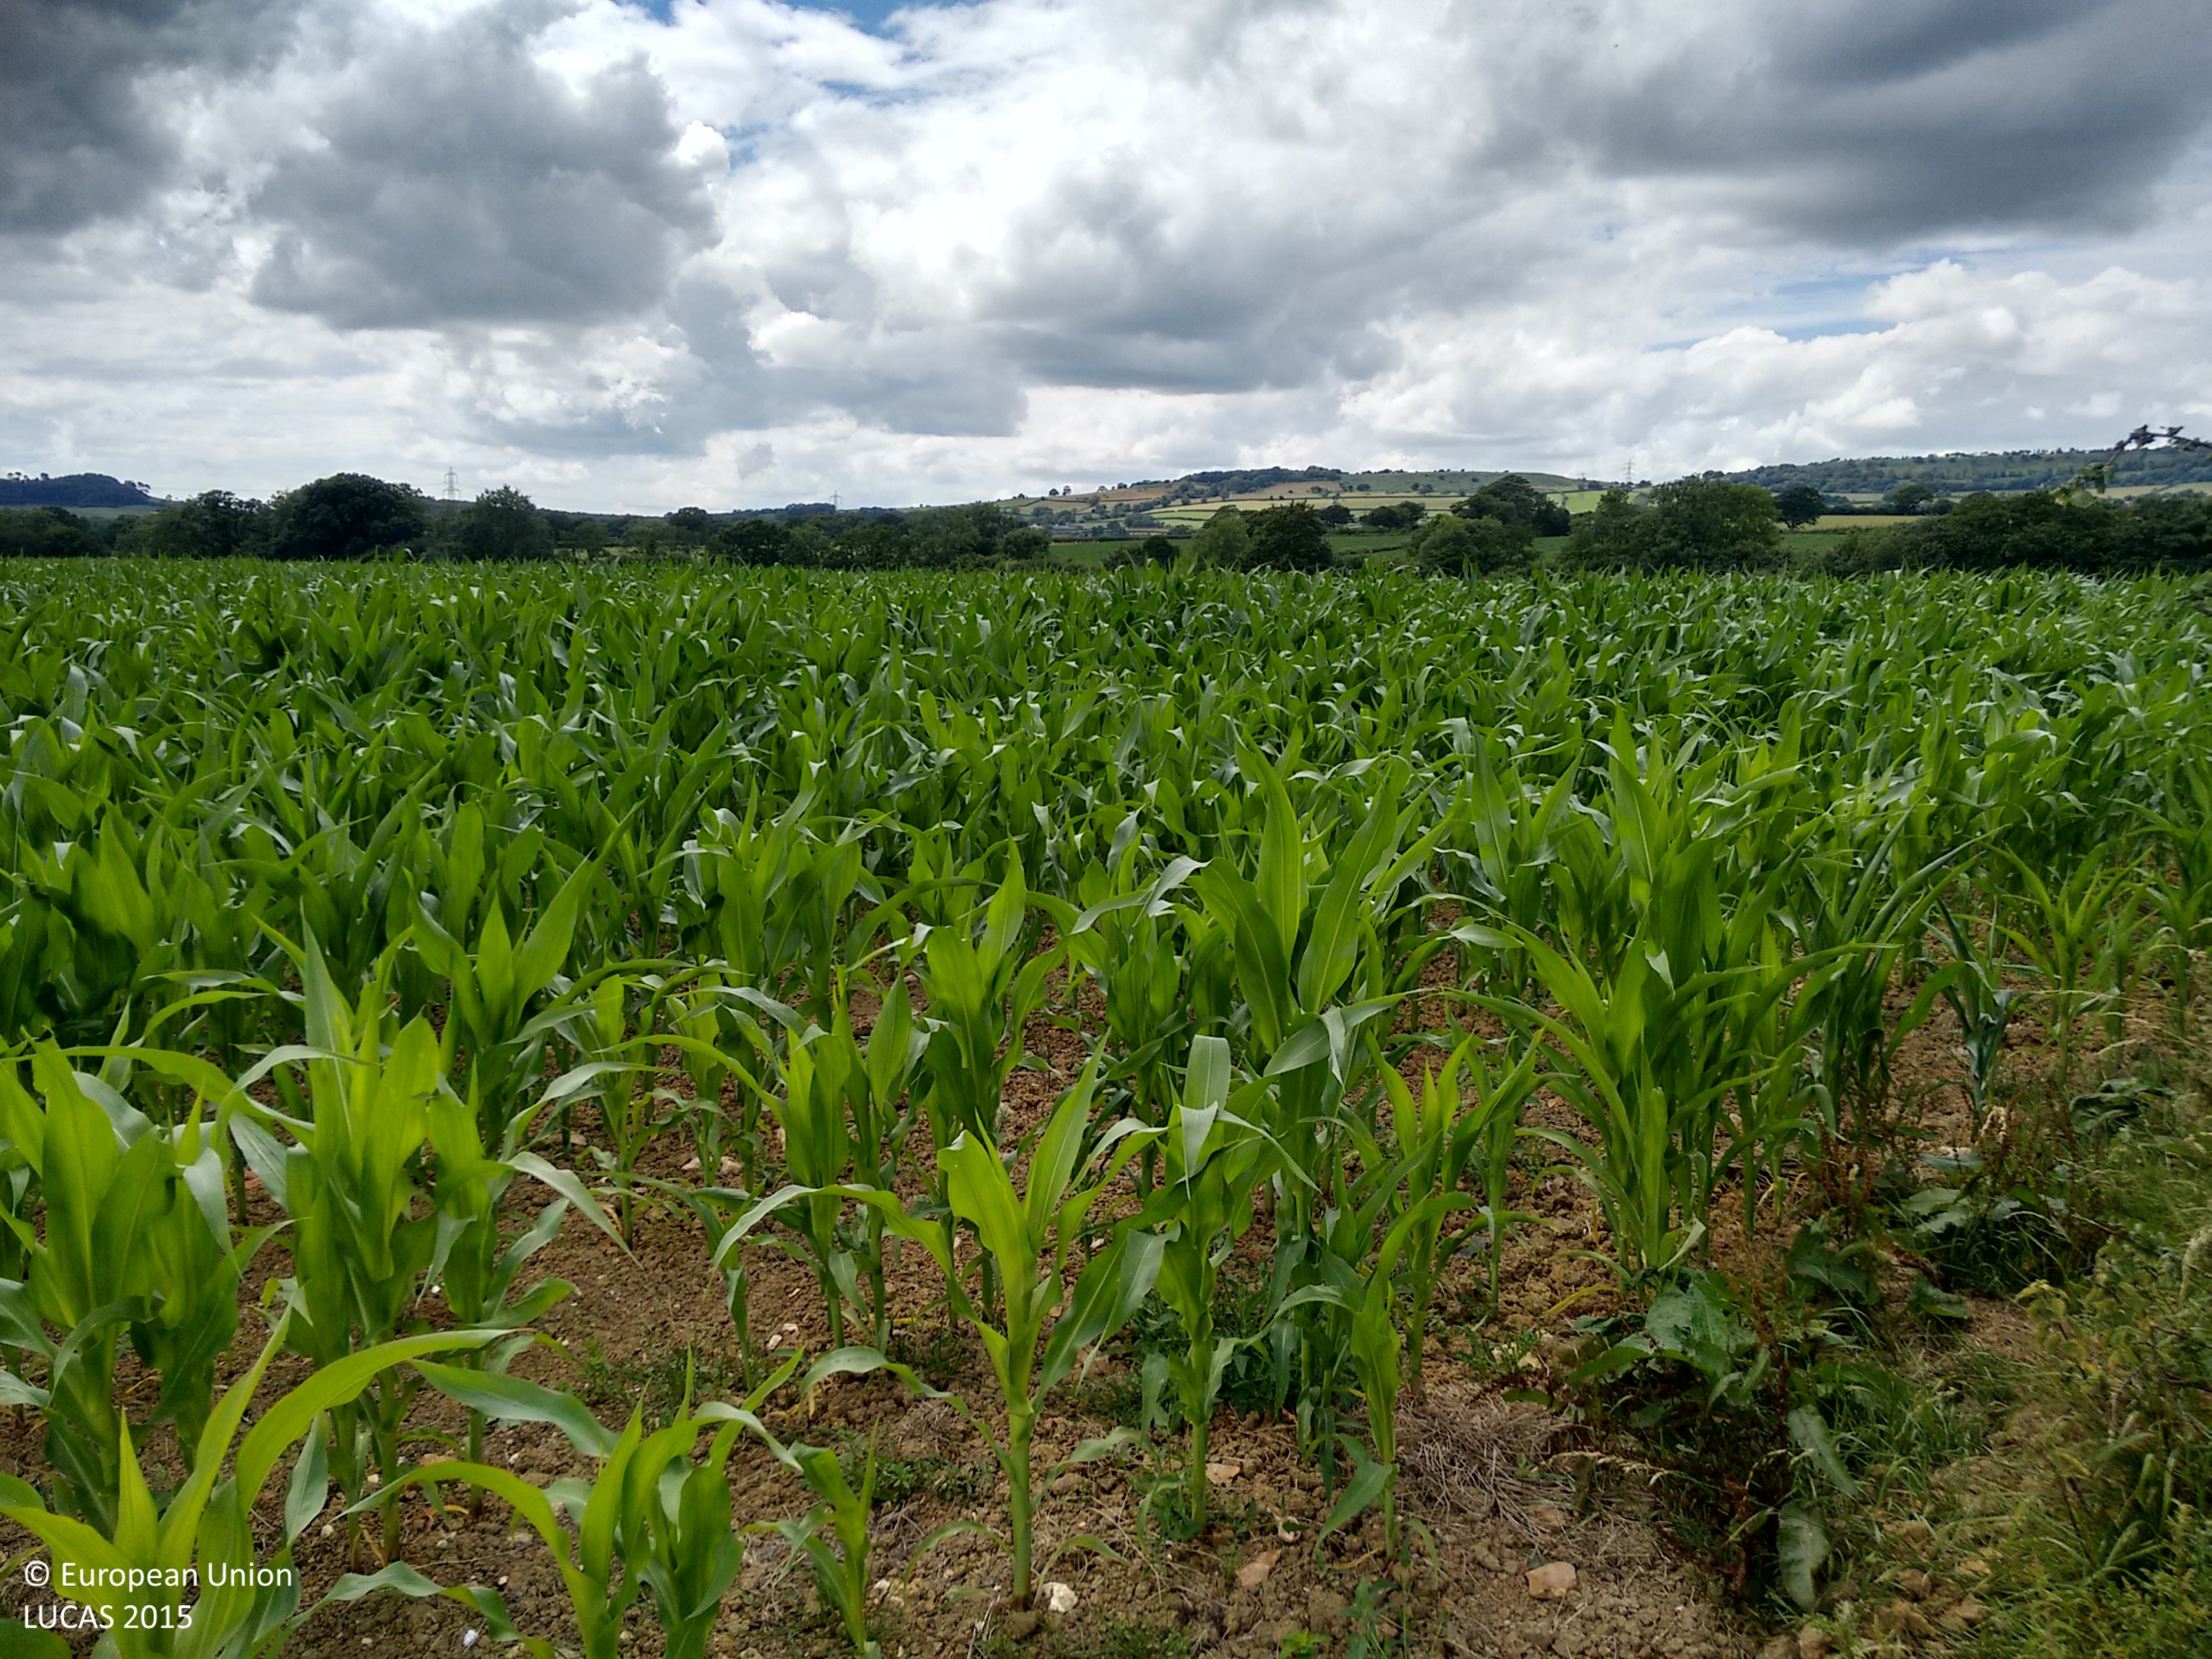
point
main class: Cropland
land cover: Maize
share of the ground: > 75 %
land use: Agriculture (excluding fallow land and kitchen gardens)
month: July
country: GB
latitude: 50.7828
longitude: -2.8513
